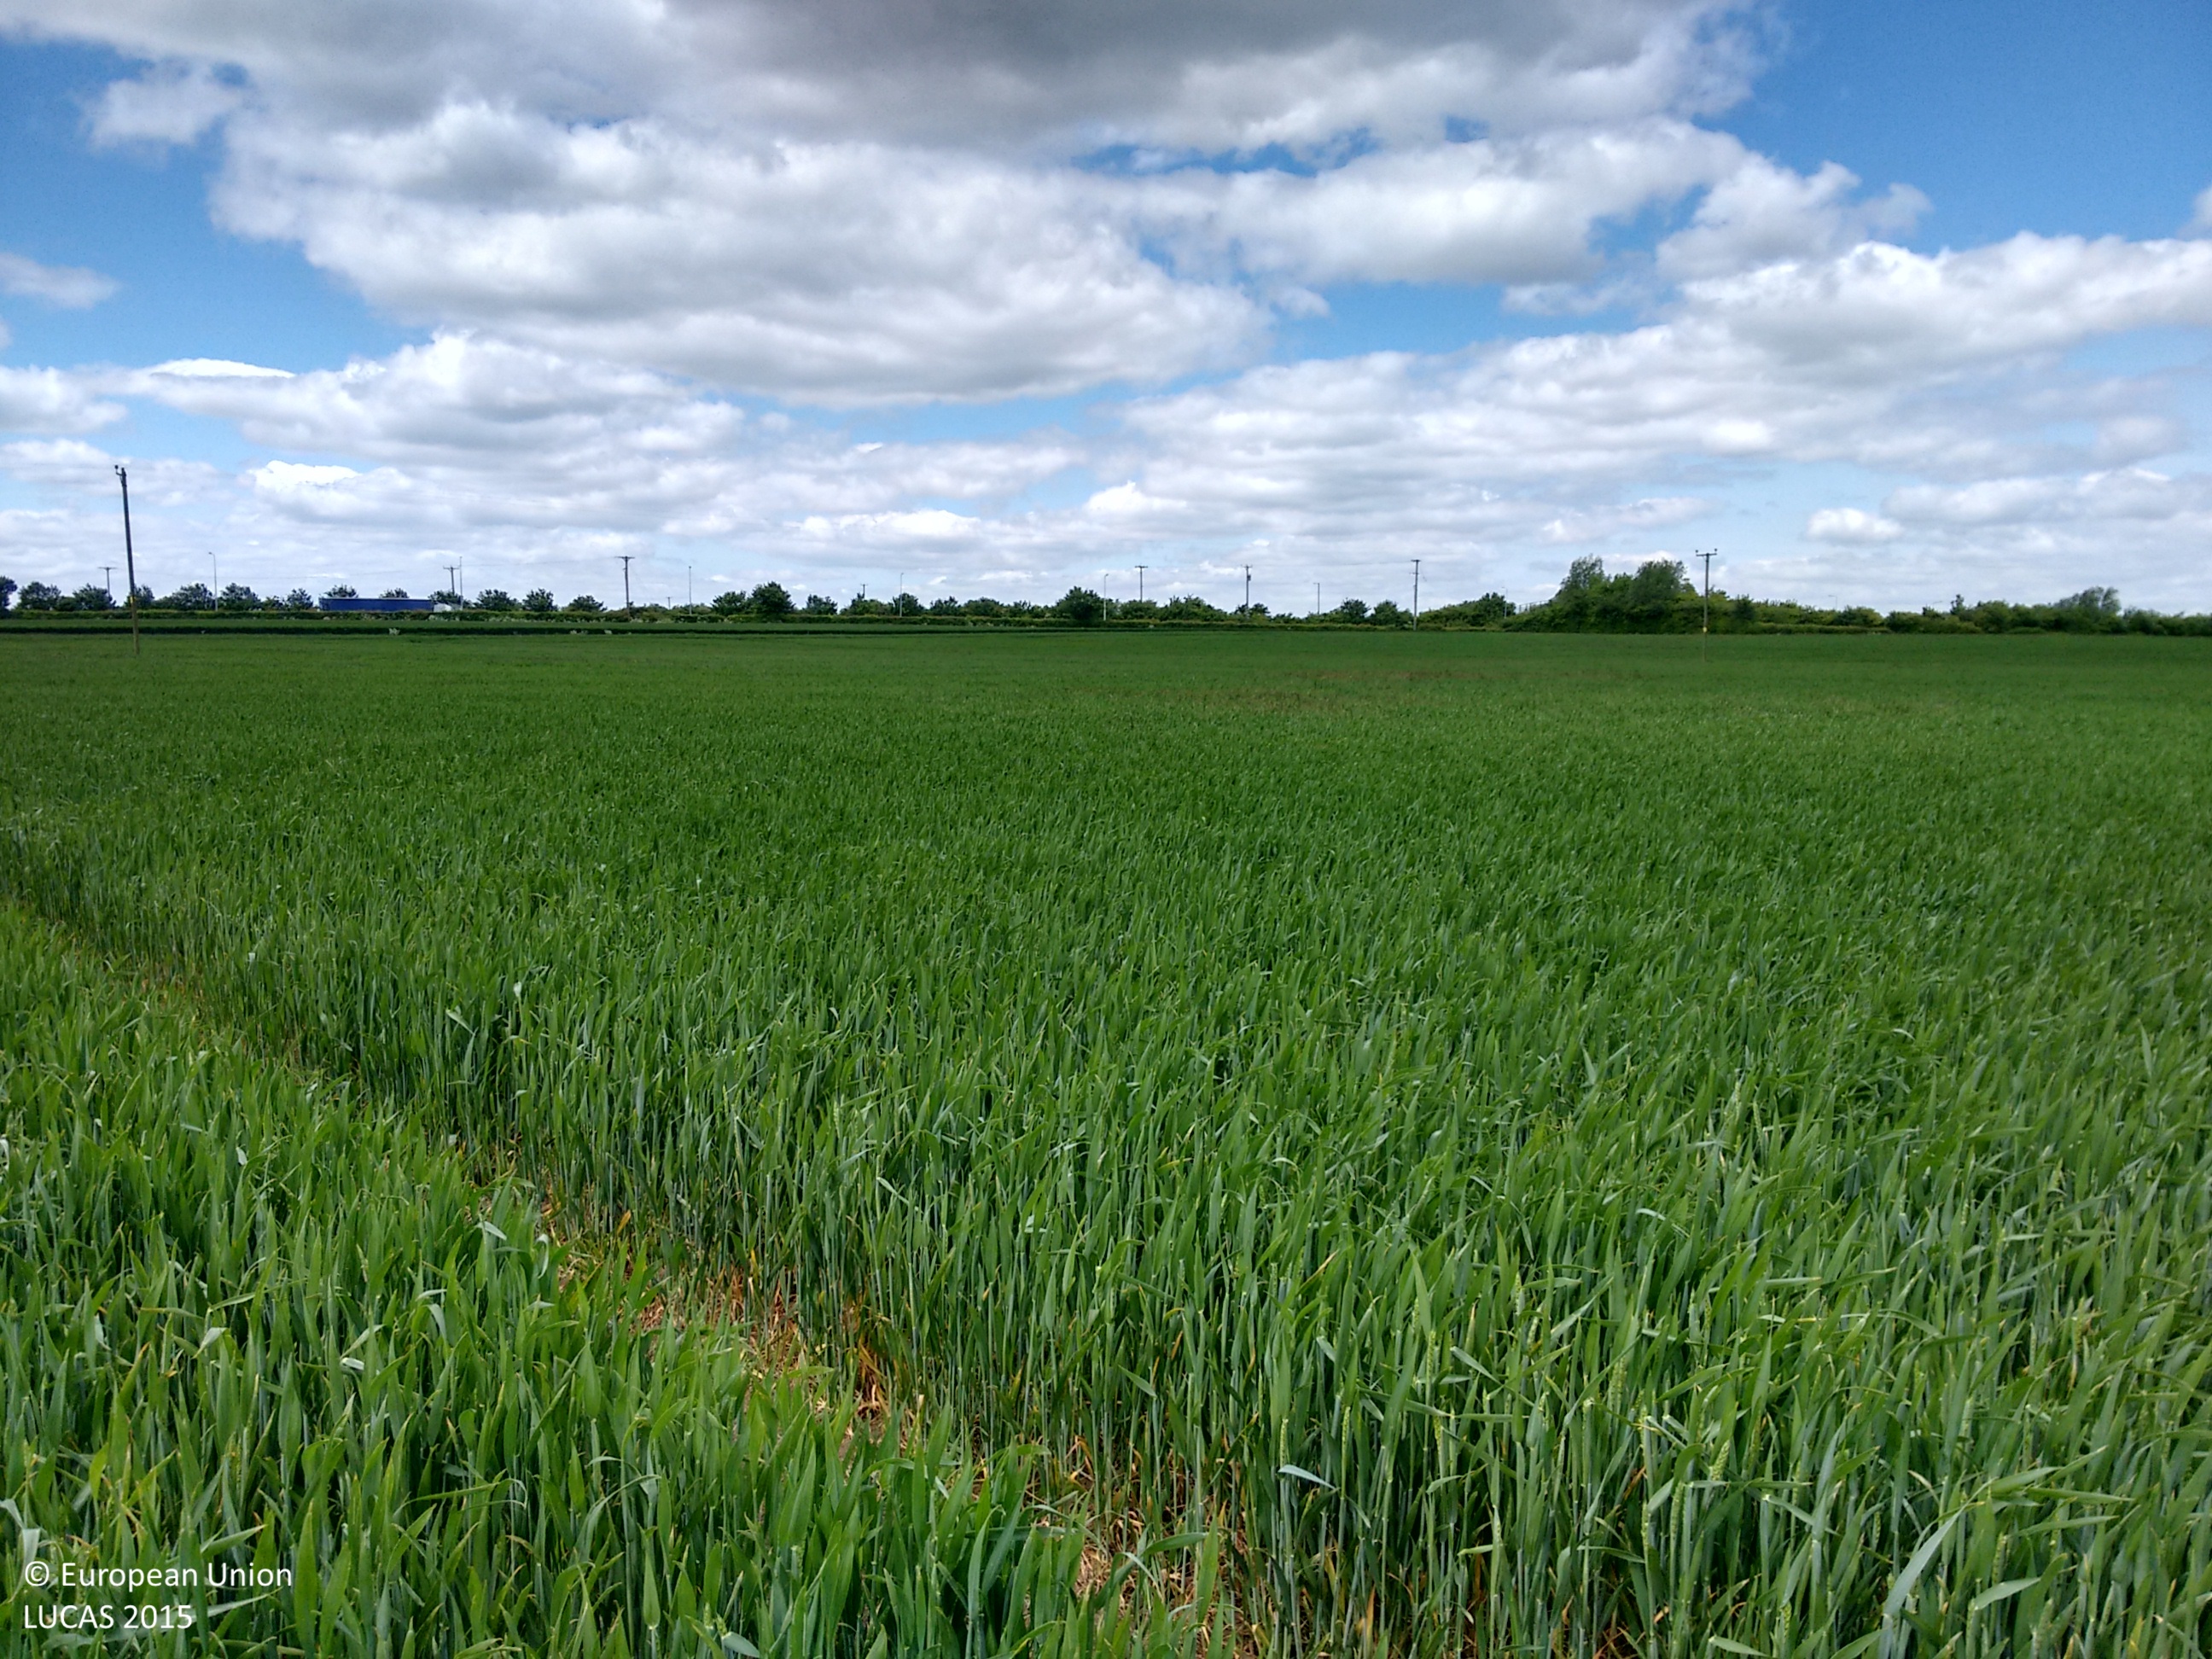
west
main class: Cropland
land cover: Common wheat
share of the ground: > 75 %
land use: Agriculture (excluding fallow land and kitchen gardens)
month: June
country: GB
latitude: 53.5431
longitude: -0.0677
